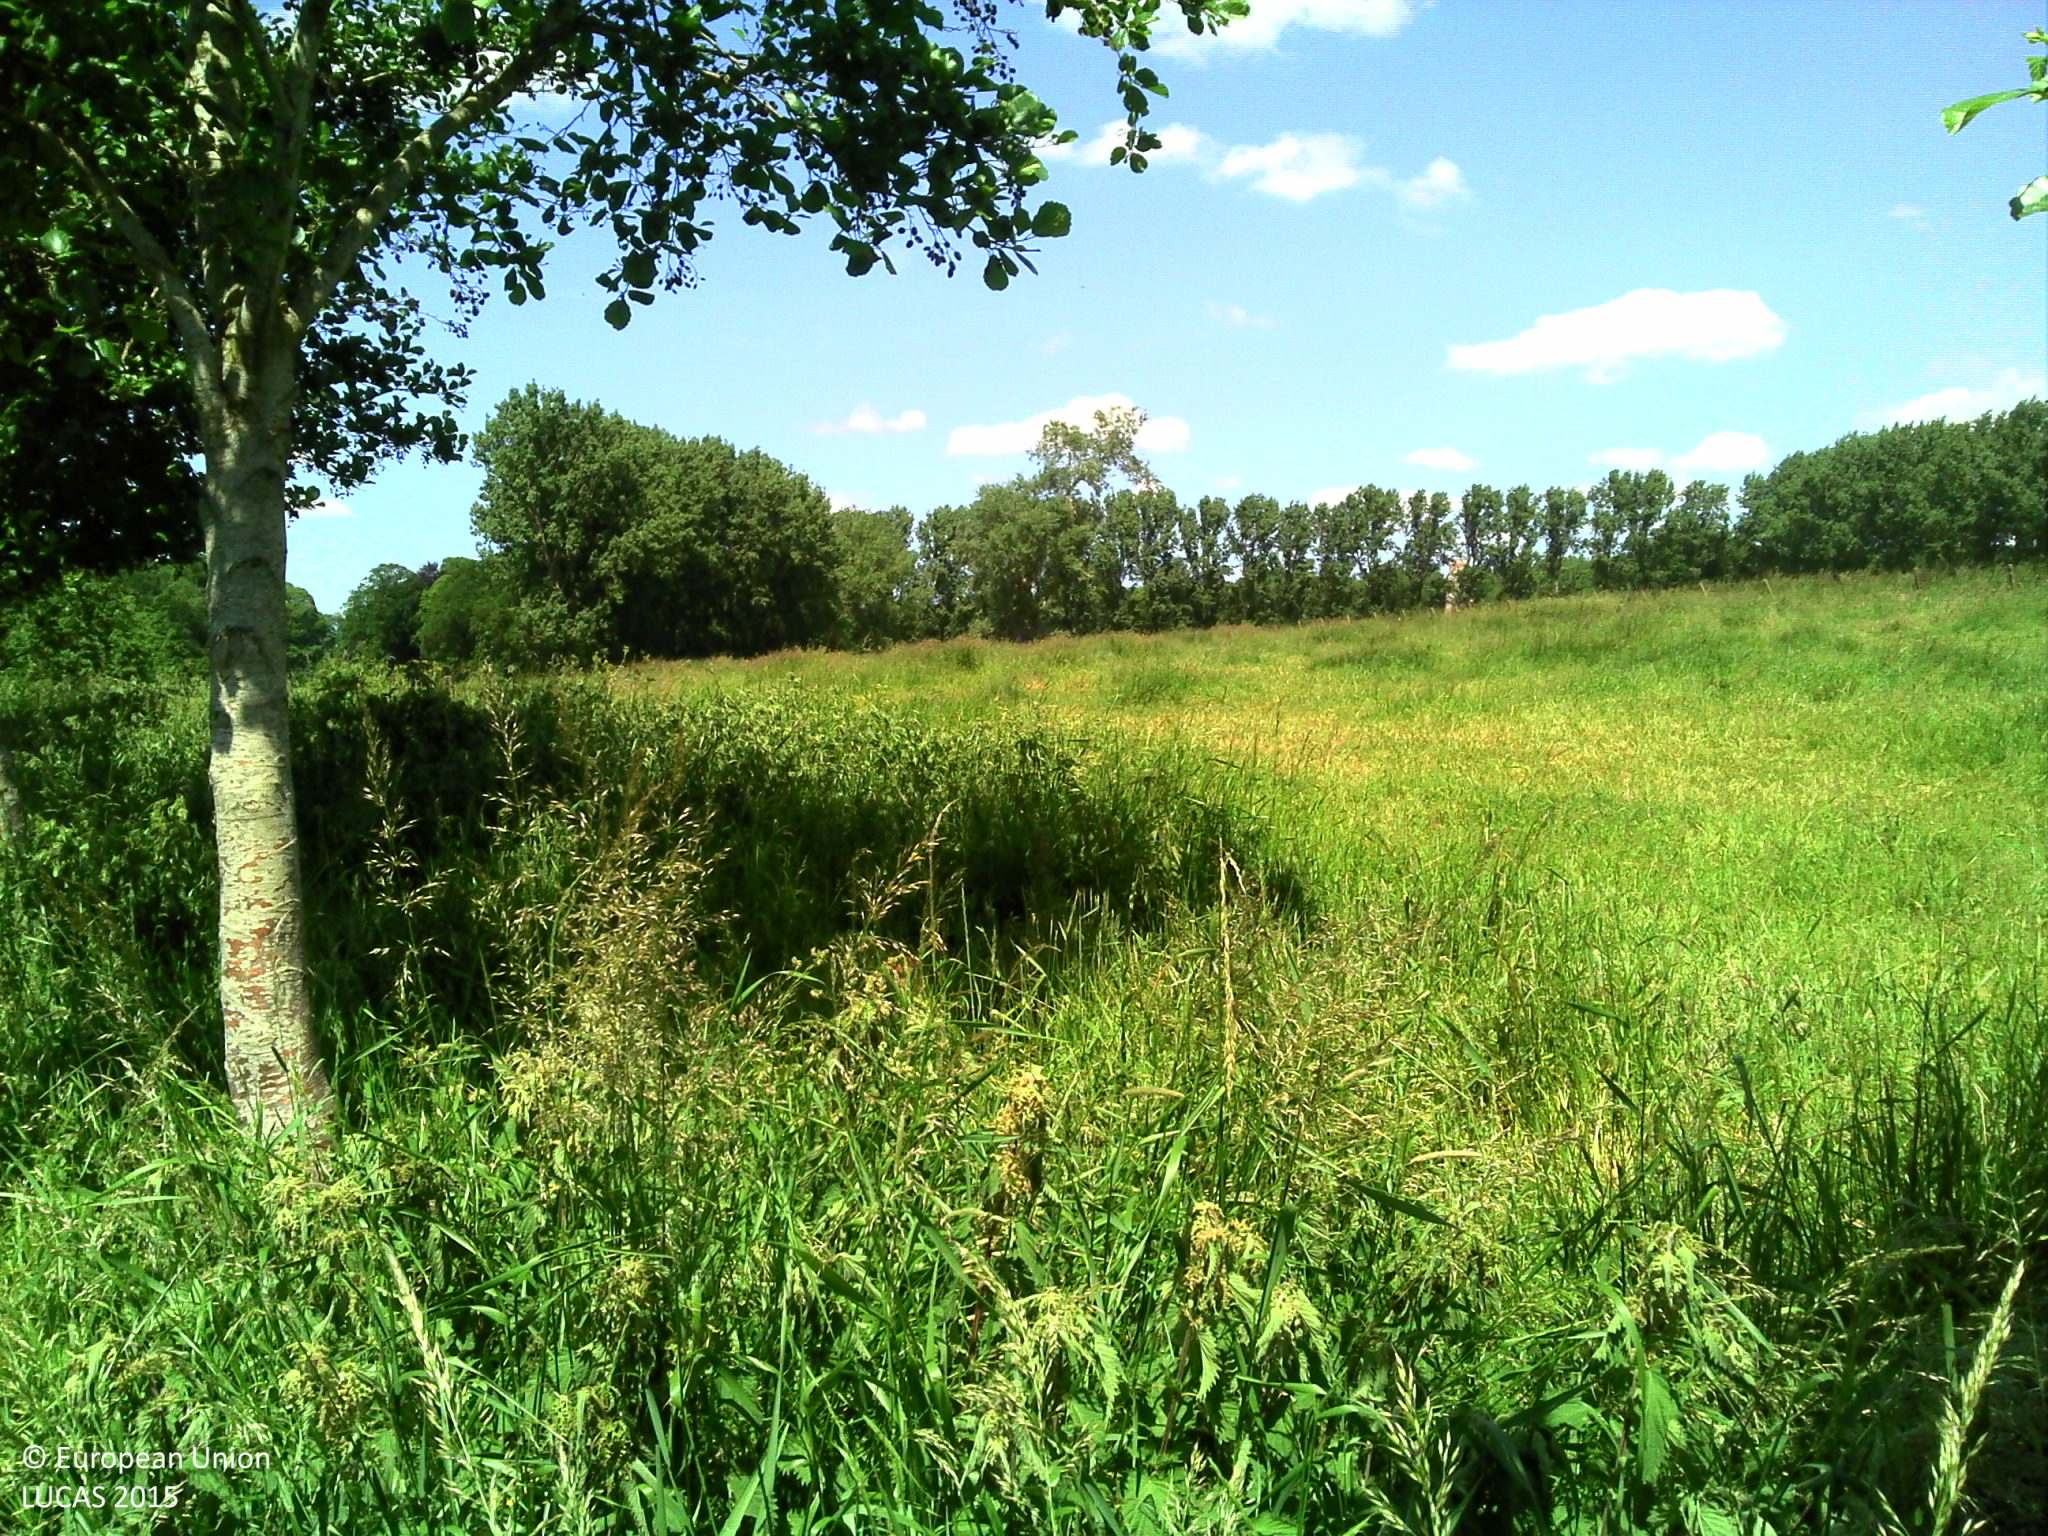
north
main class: Grassland
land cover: Spontaneously vegetated surfaces
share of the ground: > 75 %
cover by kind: herbaceous plants 100 %
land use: Semi-natural and natural areas not in use
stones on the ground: < 10 %
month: June
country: BE
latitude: 50.8779
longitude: 2.8117
